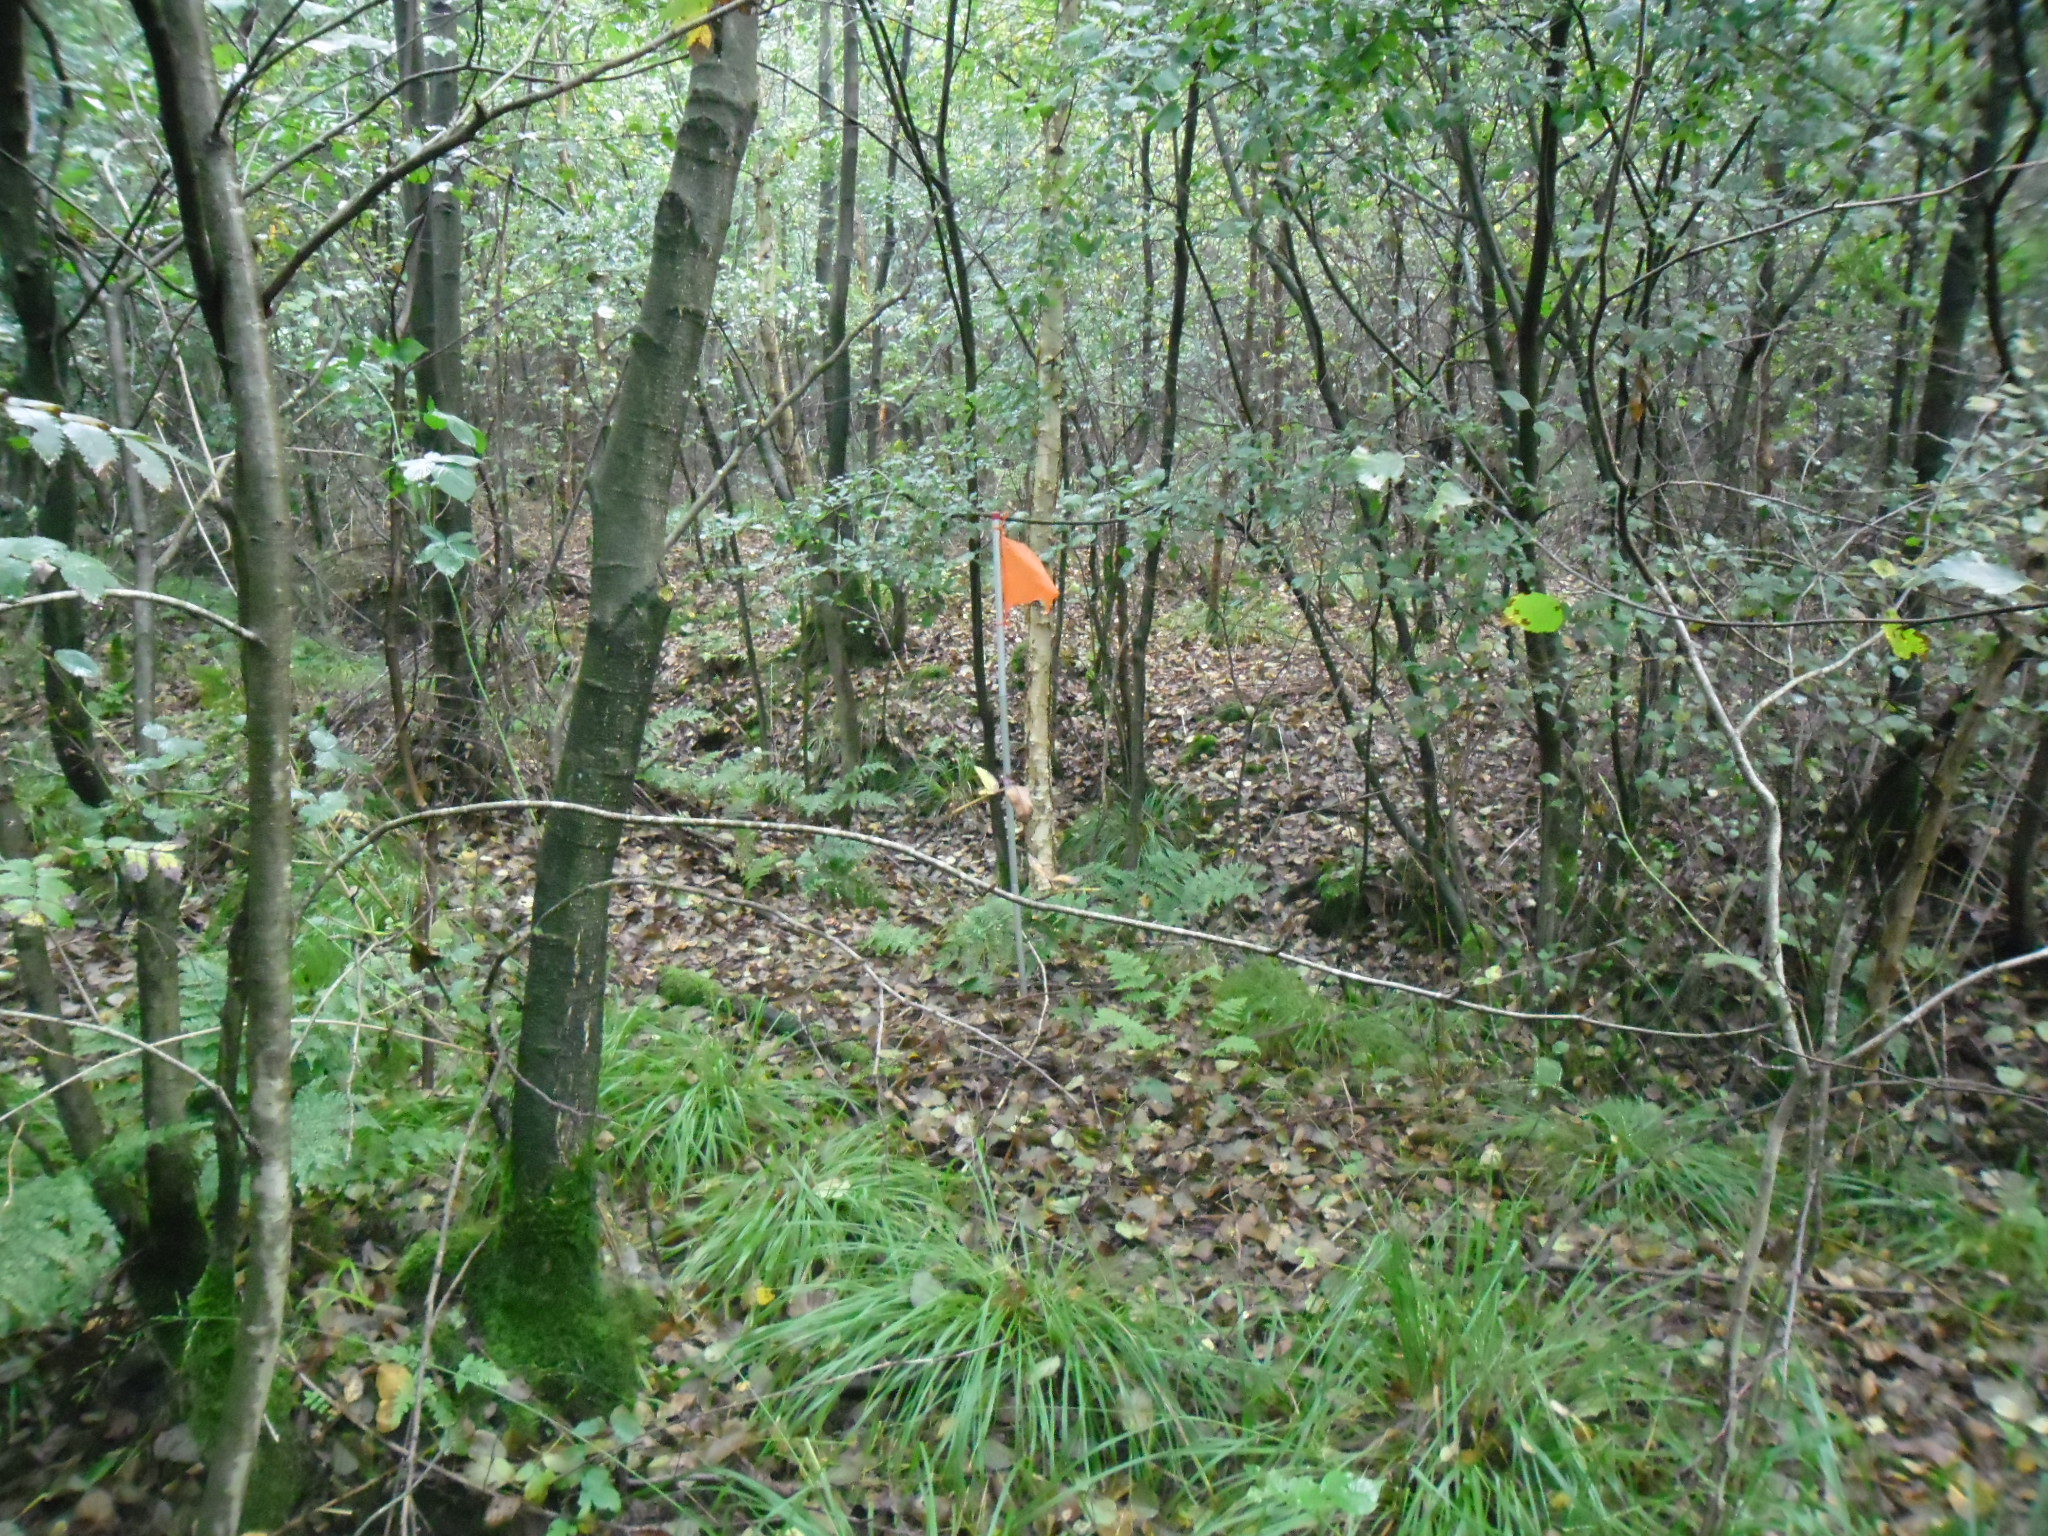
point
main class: Woodland
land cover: Broadleaved woodland
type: mesophytic deciduous forest
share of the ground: > 75 %
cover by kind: broadleaved forest trees 100 %
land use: Forestry
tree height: > 5 m
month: September
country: NL
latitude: 52.0937
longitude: 5.4880
